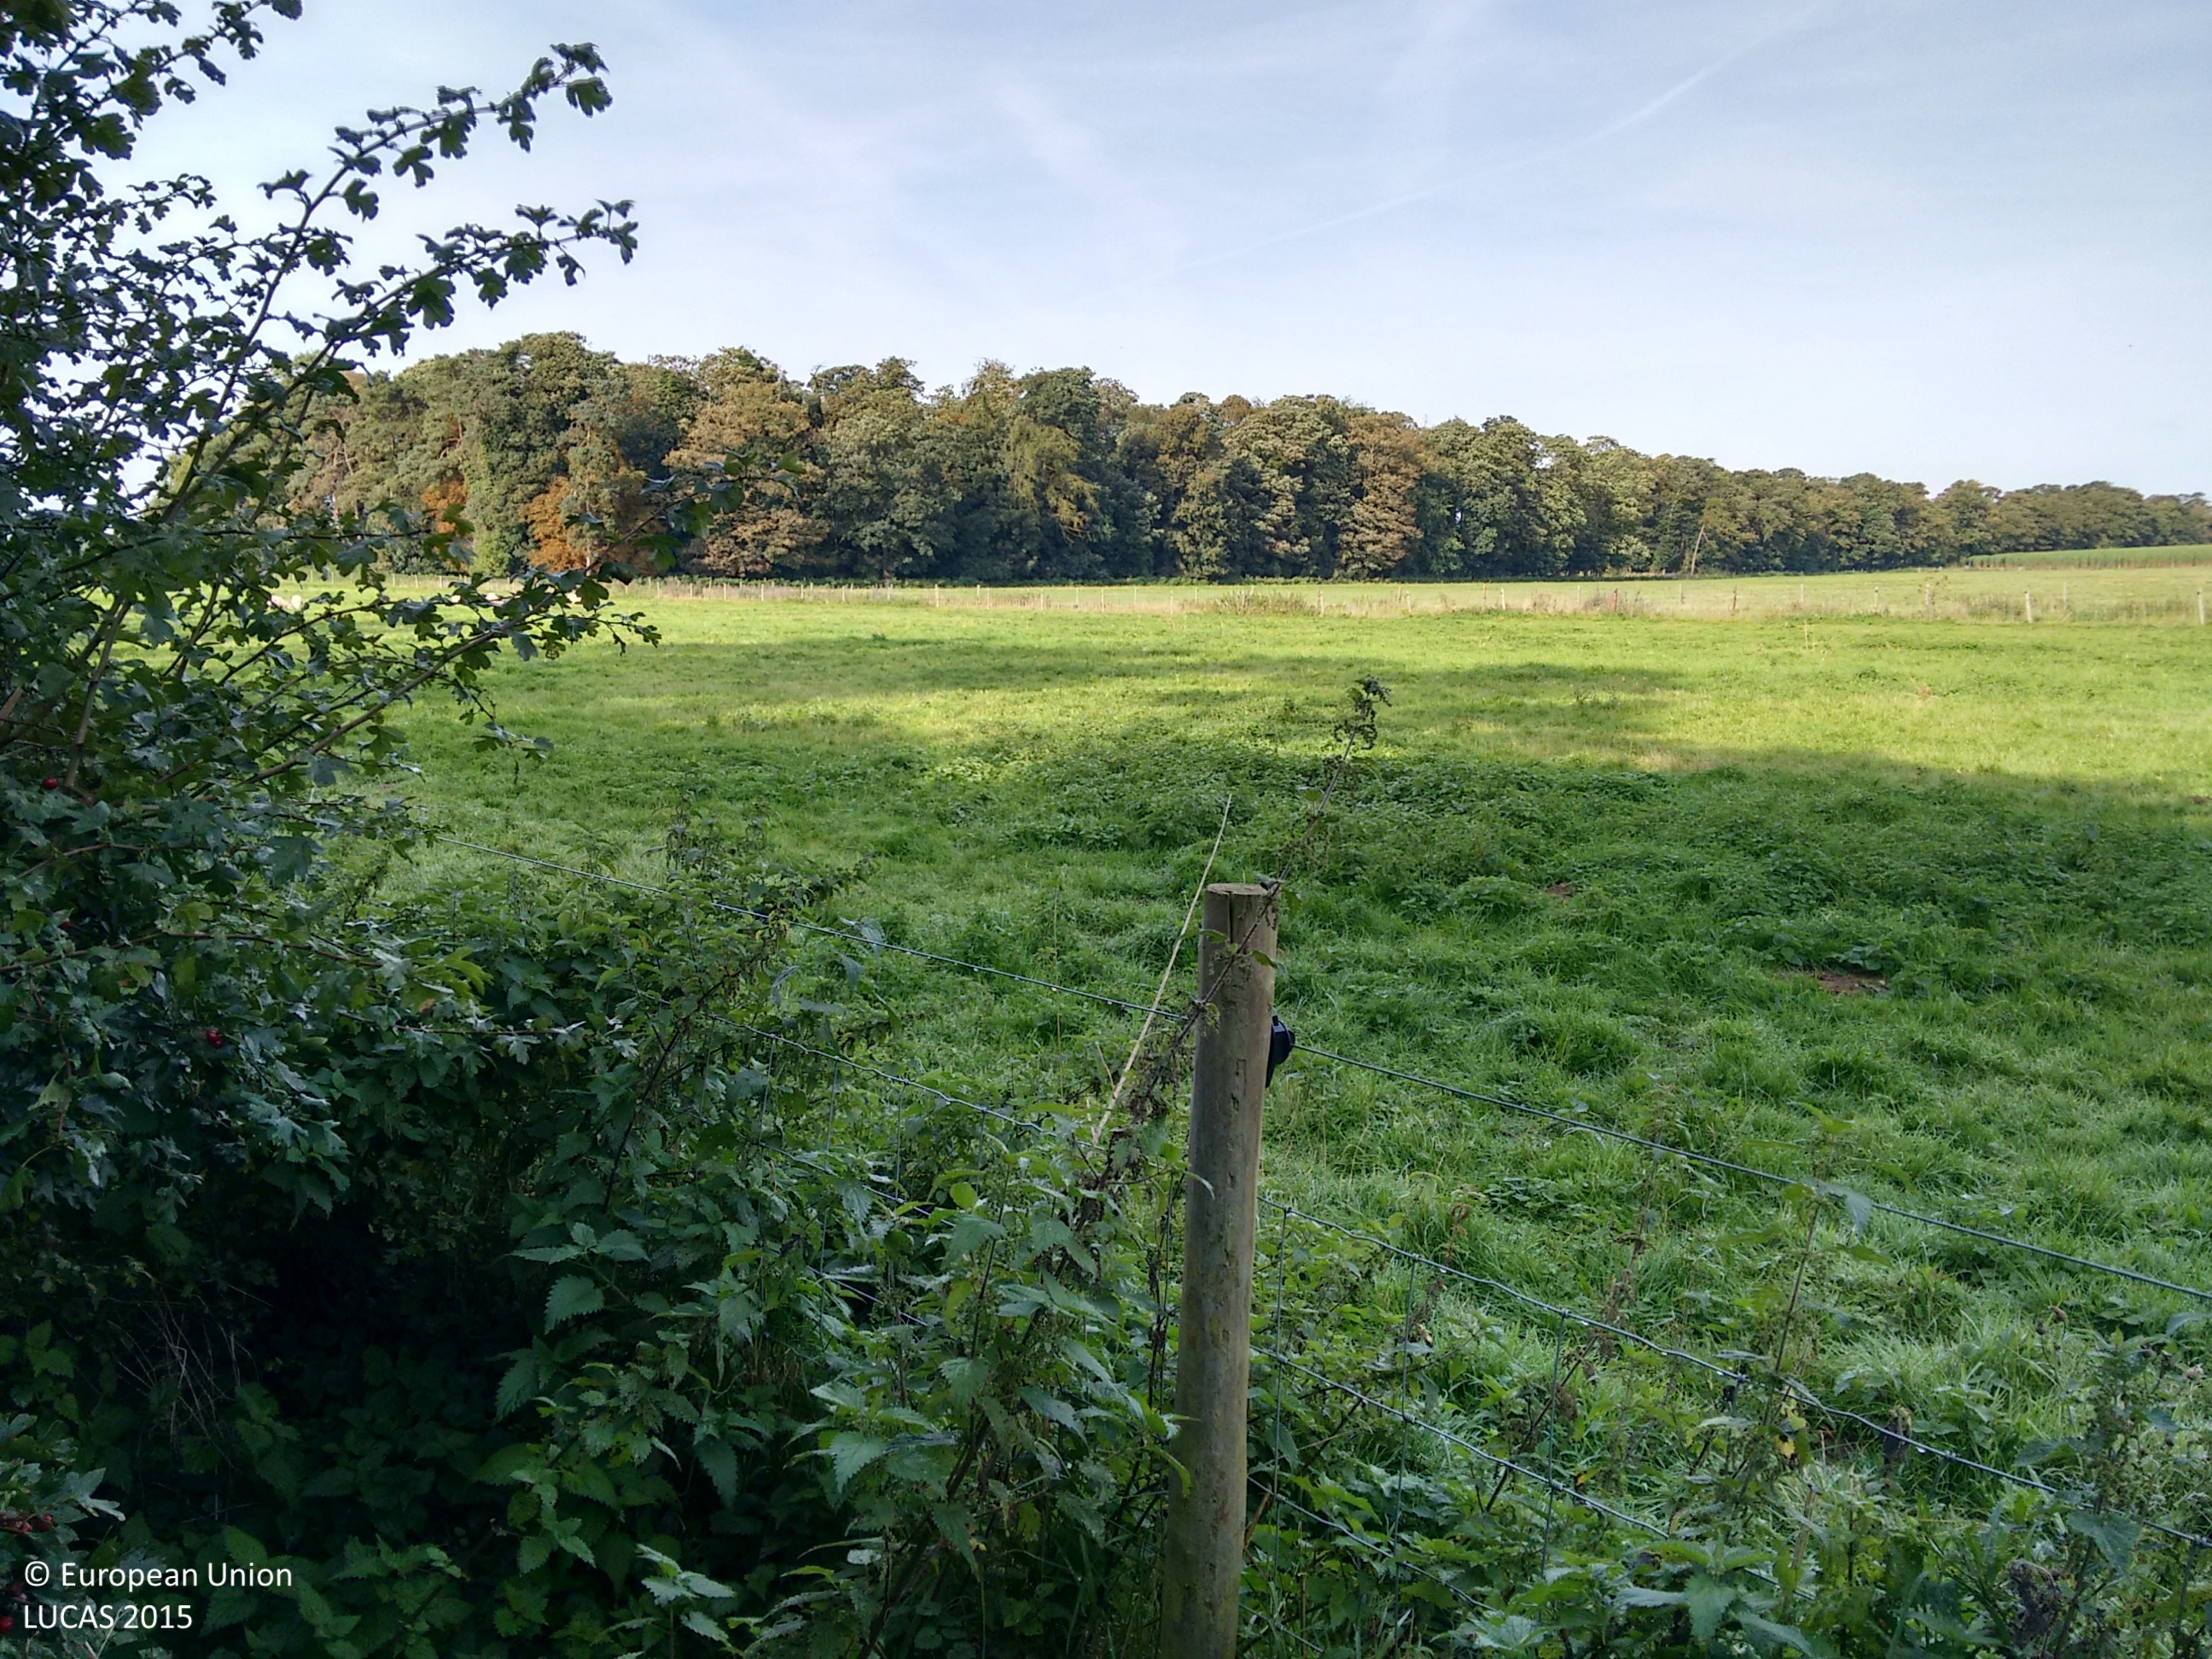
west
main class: Grassland
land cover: Grassland without tree/shrub cover
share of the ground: > 75 %
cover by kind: herbaceous plants 100 %
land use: Agriculture (excluding fallow land and kitchen gardens)
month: September
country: GB
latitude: 52.4211
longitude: 0.8441
